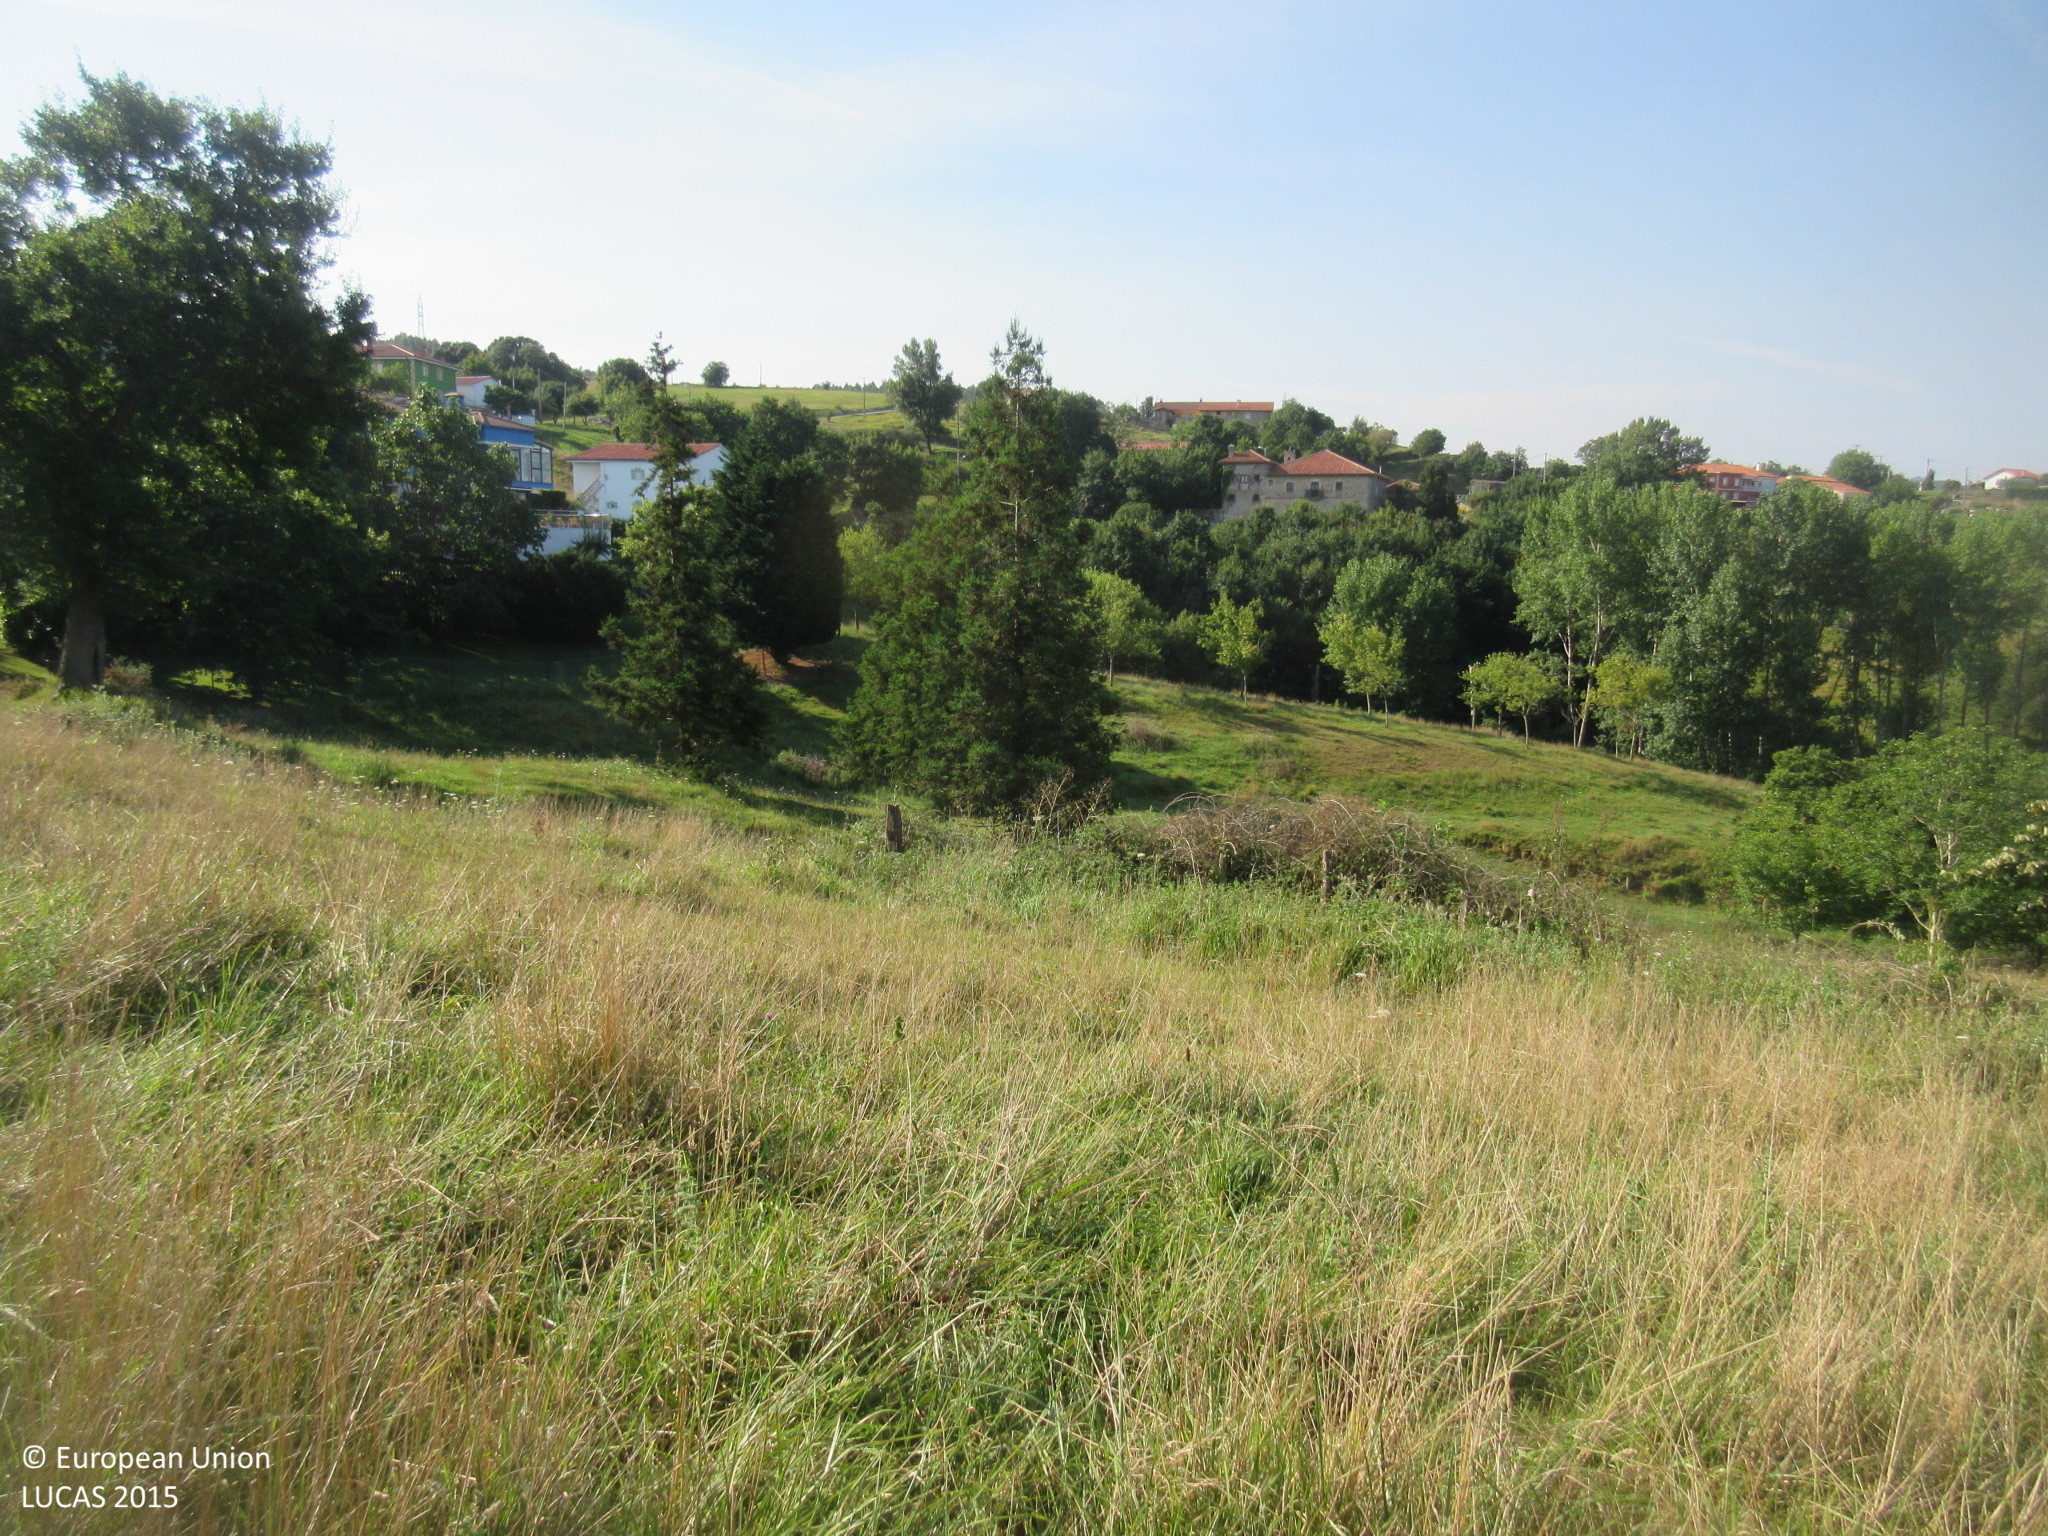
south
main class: Grassland
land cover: Grassland without tree/shrub cover
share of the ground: > 75 %
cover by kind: herbaceous plants 100 %
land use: Agriculture (excluding fallow land and kitchen gardens)
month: July
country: ES
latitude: 43.3973
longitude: -3.9909
